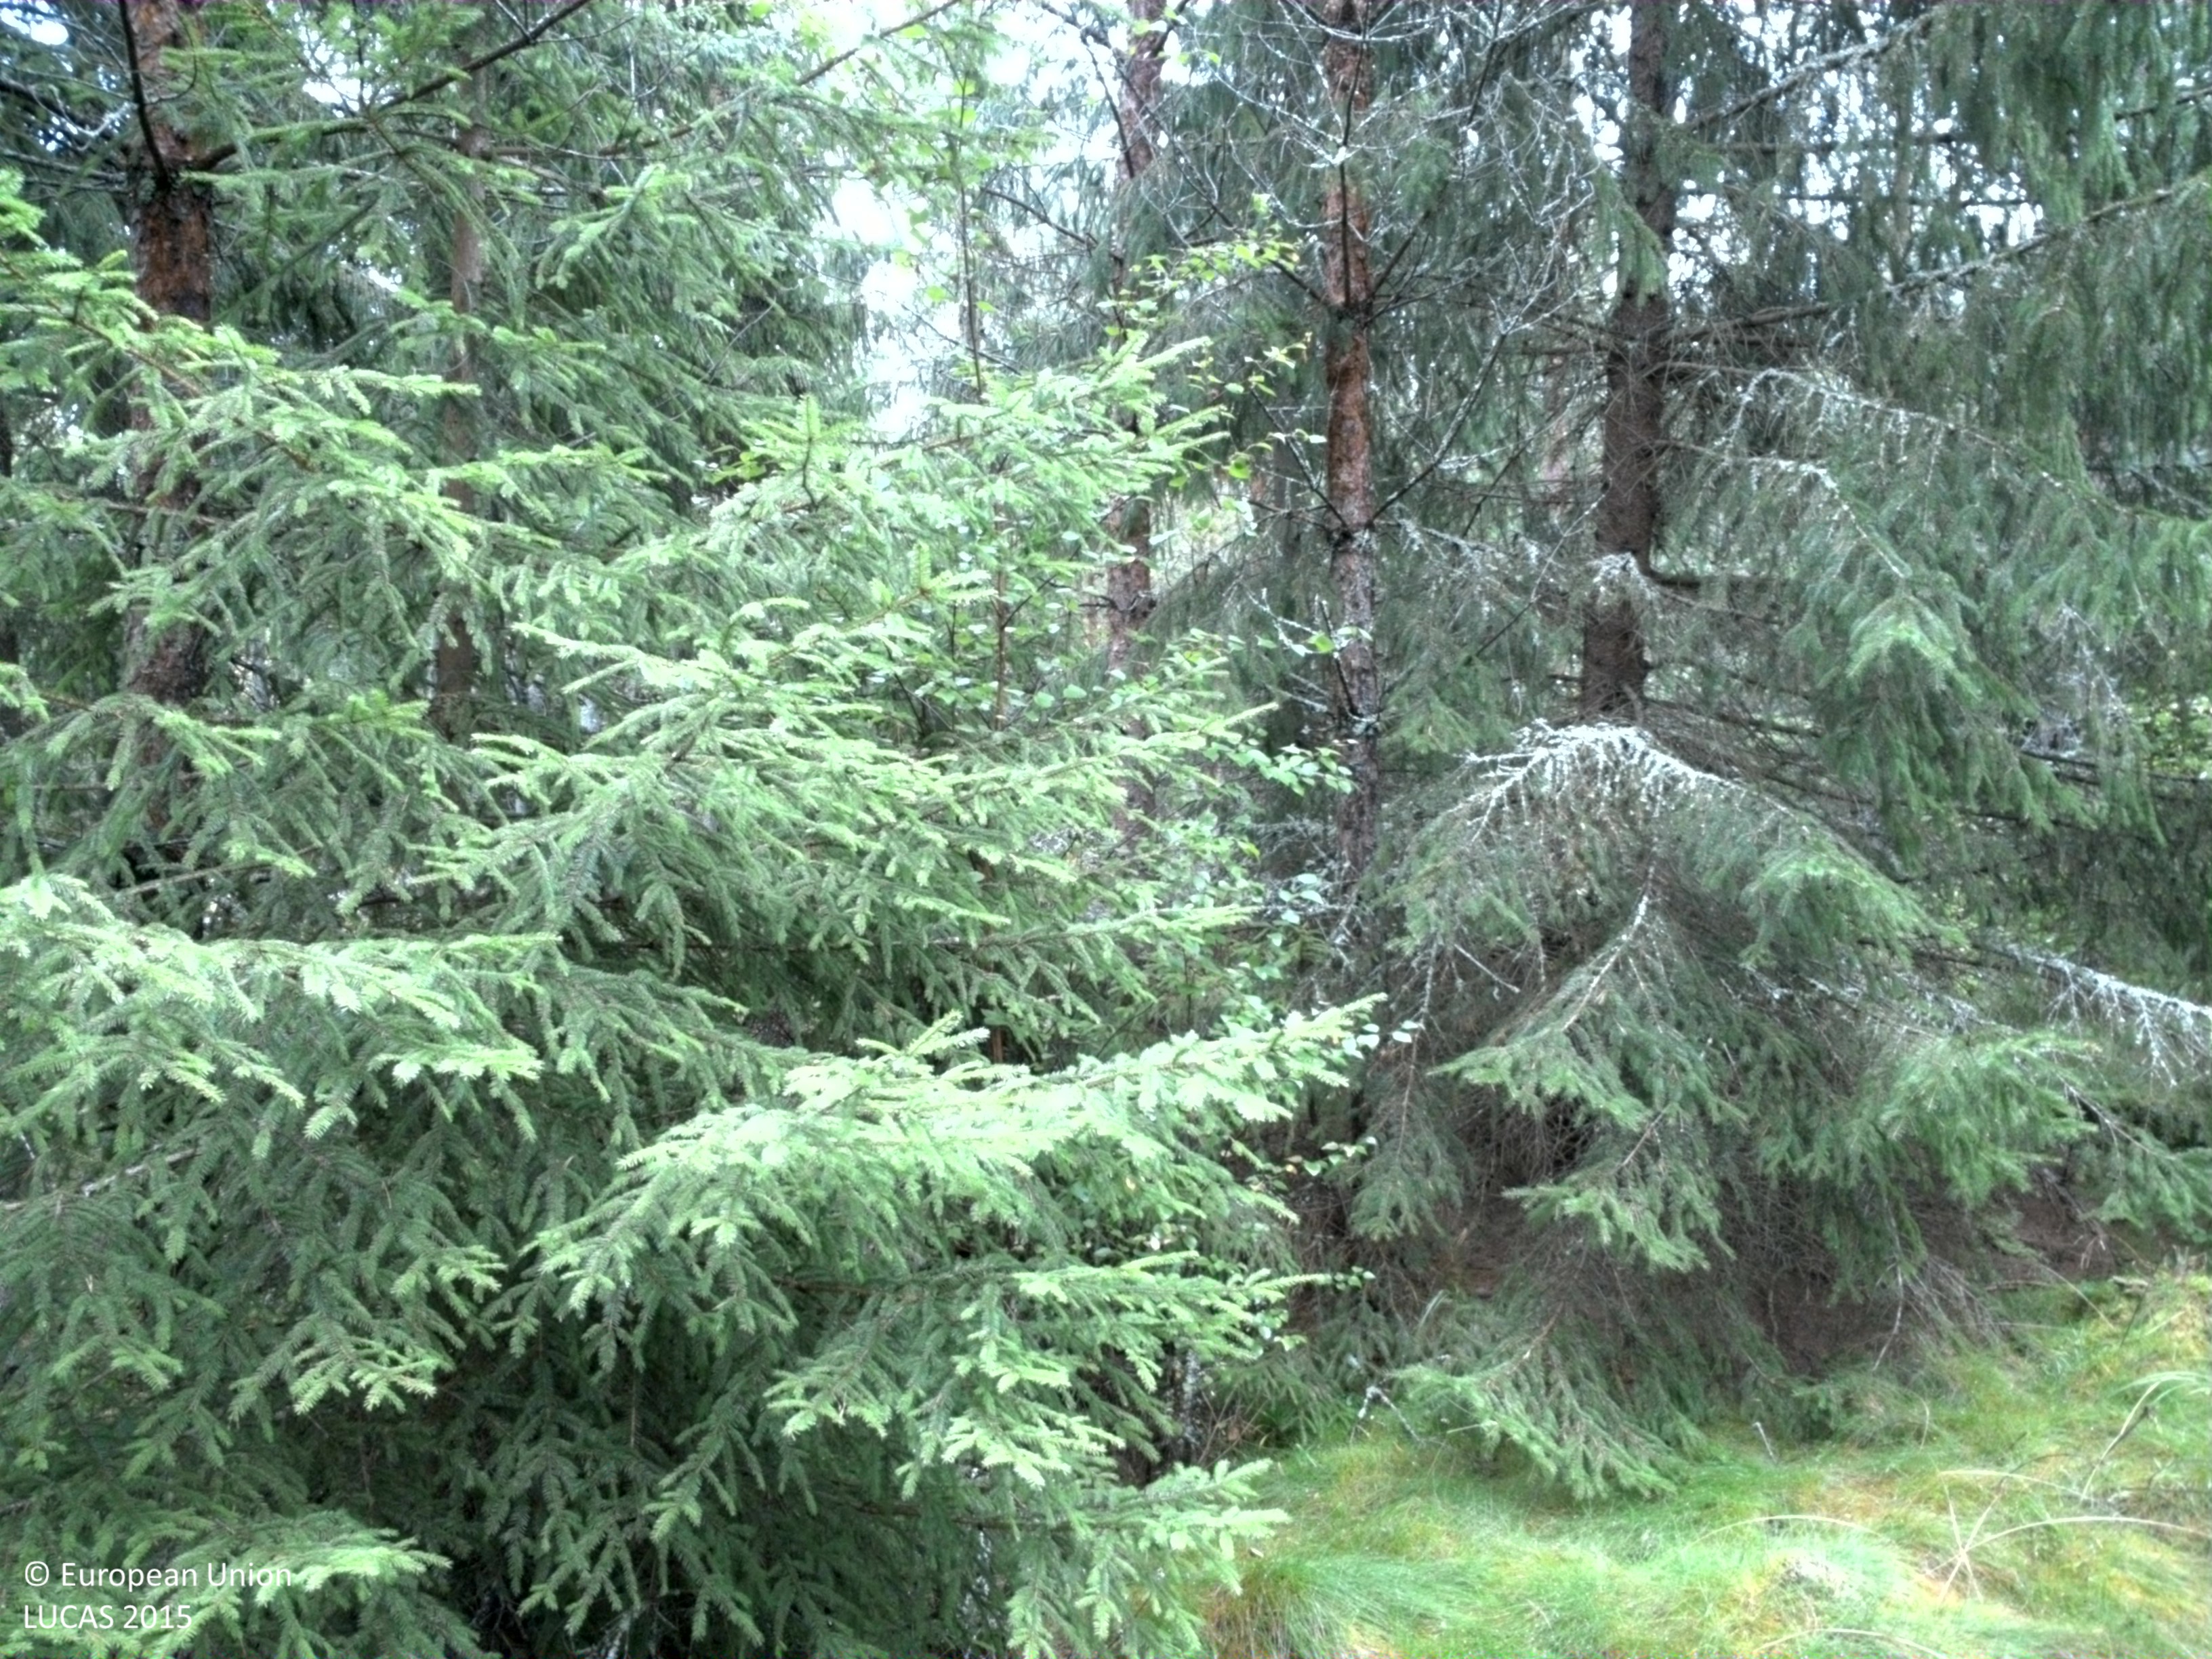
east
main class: Woodland
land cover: Pine dominated coniferous woodland
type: boreal forest
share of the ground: 50 - 75 %
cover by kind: coniferous forest trees 65 %, herbaceous plants 25 %, broadleaved forest trees 10 %
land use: Forestry
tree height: > 5 m
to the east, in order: Pine dominated coniferous woodland; Spruce dominated coniferous woodland; Pine dominated coniferous woodland; Spruce dominated coniferous woodland; Ditches and canals; Other bare soil; Spontaneously vegetated surfaces
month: August
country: SE
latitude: 59.9355
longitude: 17.6713
